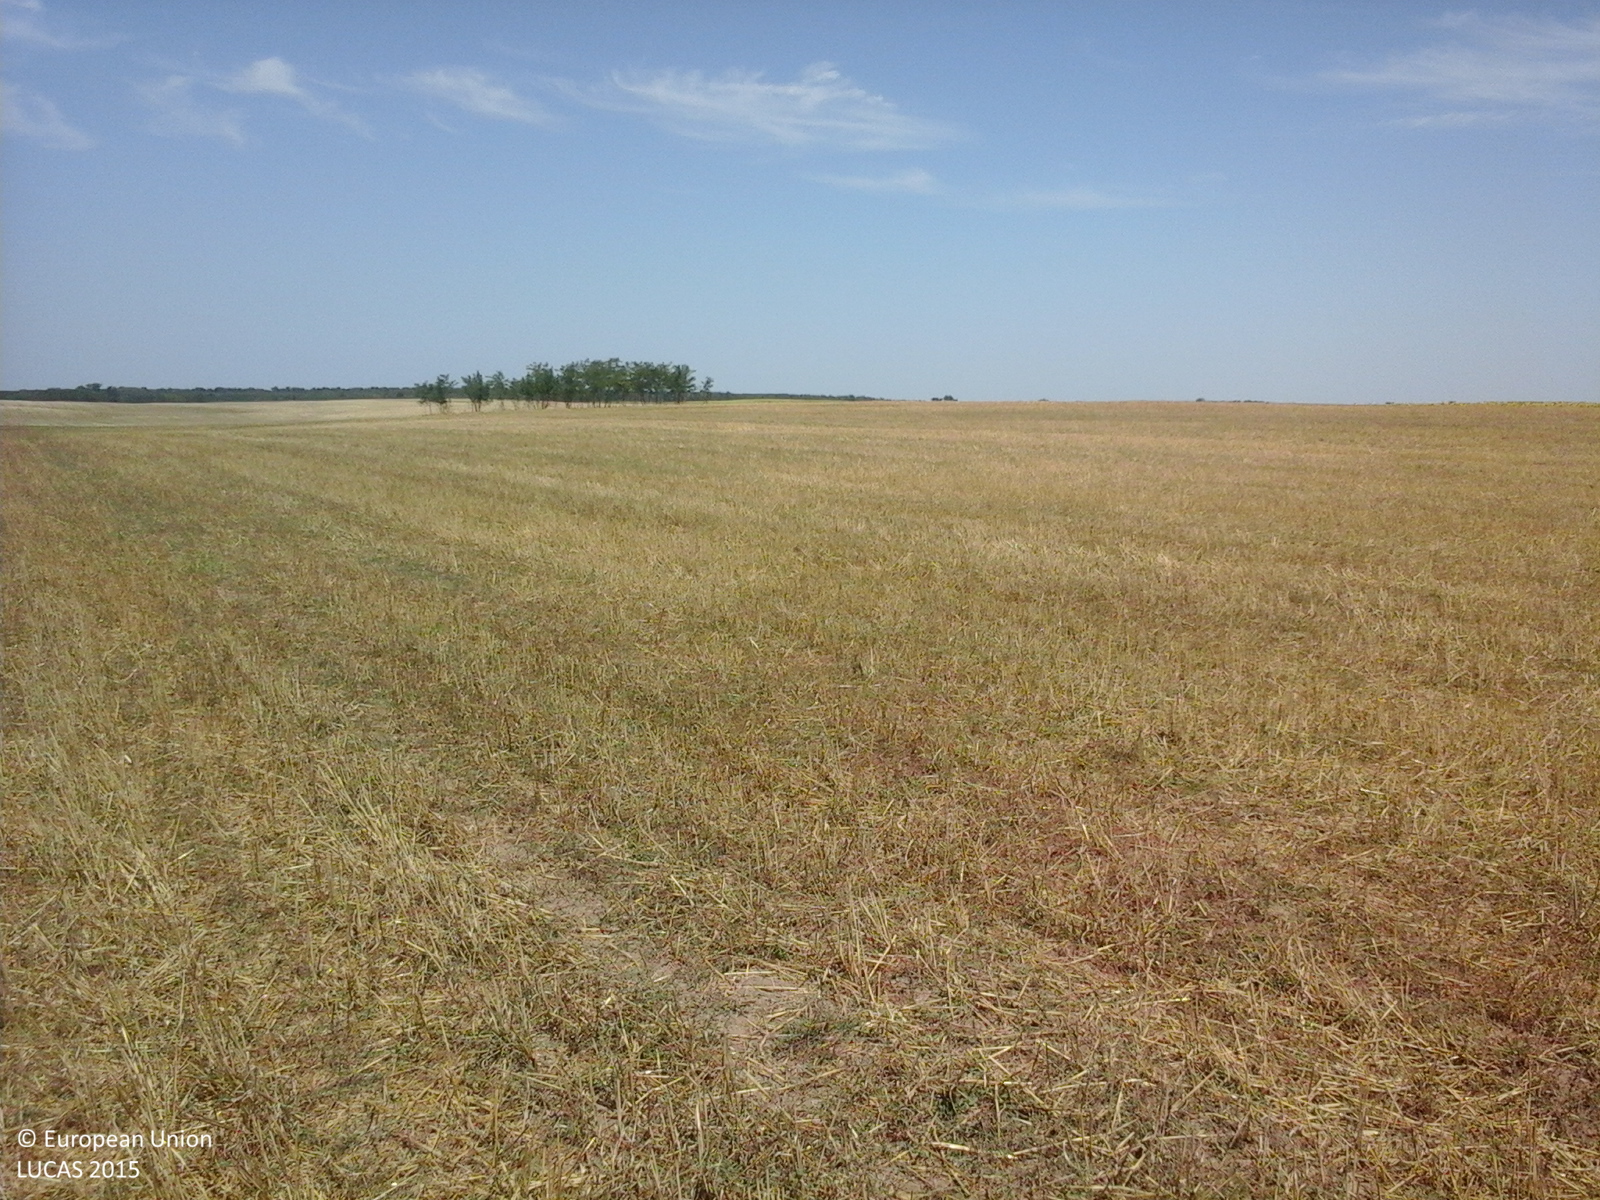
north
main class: Cropland
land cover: Barley
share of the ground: > 75 %
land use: Agriculture (excluding fallow land and kitchen gardens)
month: August
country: RO
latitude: 45.7552
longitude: 27.5250
